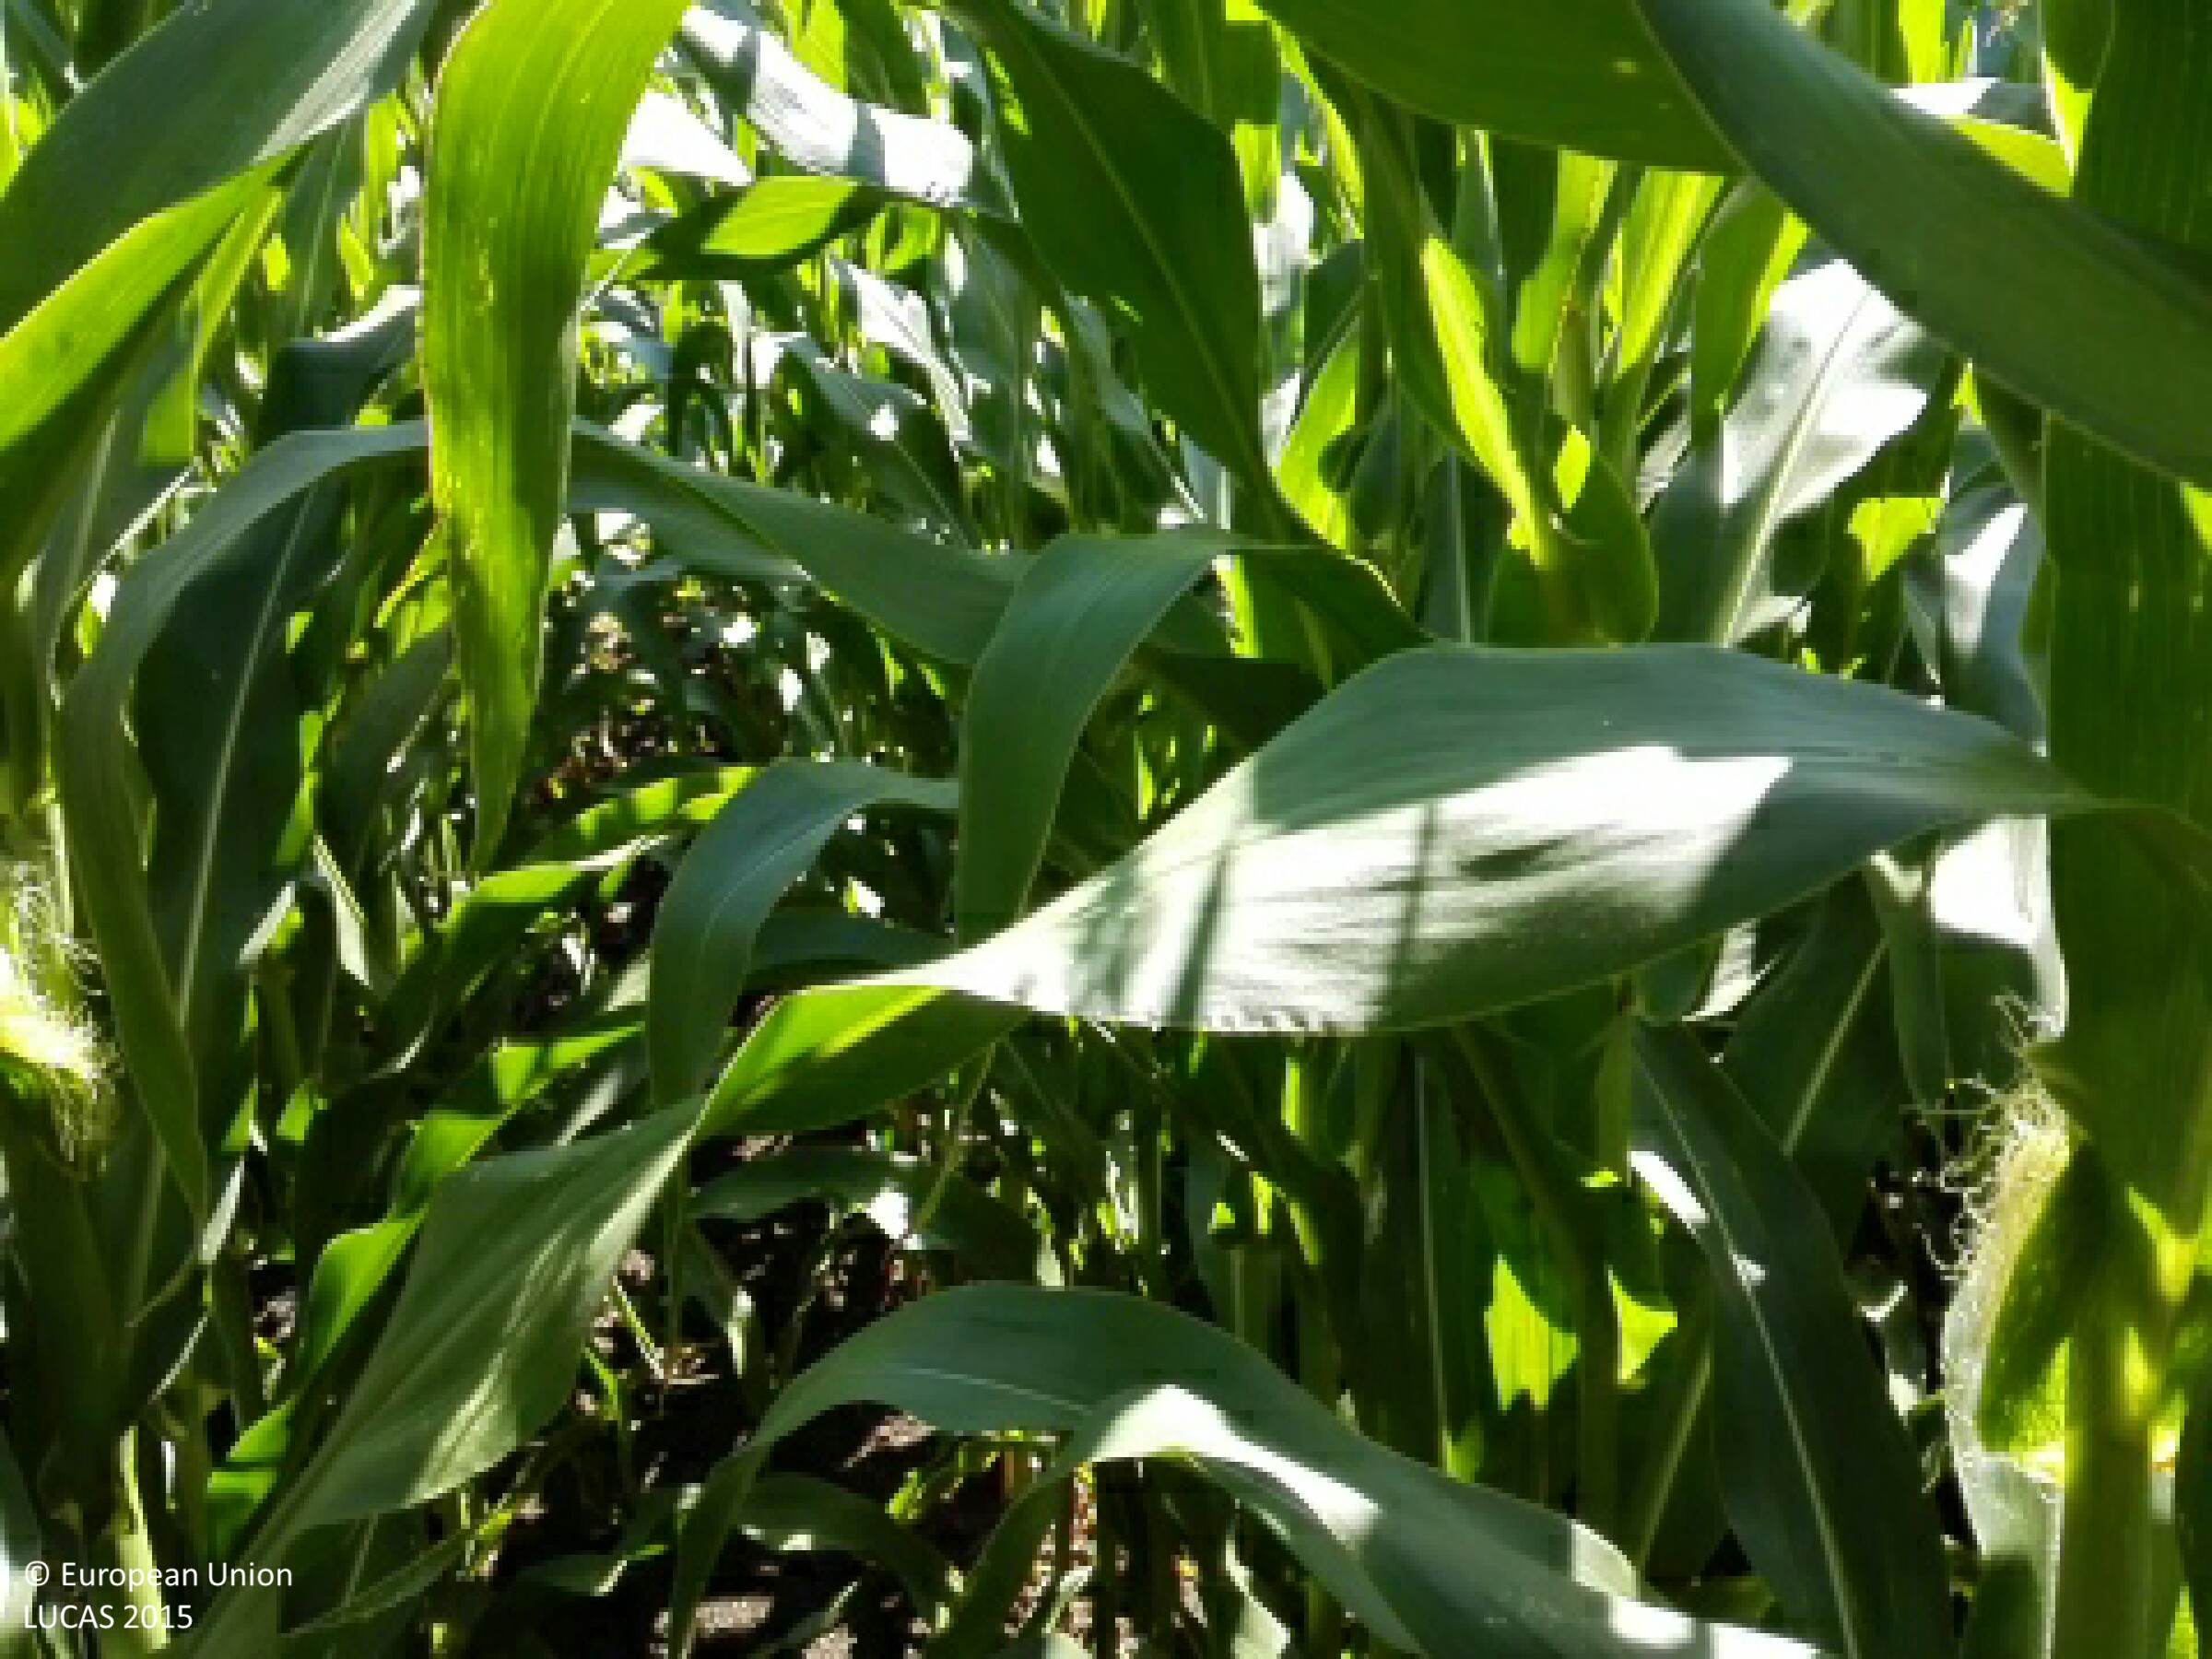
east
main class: Cropland
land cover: Maize
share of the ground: > 75 %
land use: Agriculture (excluding fallow land and kitchen gardens)
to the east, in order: Maize
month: July
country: HU
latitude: 47.7400
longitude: 21.3914
